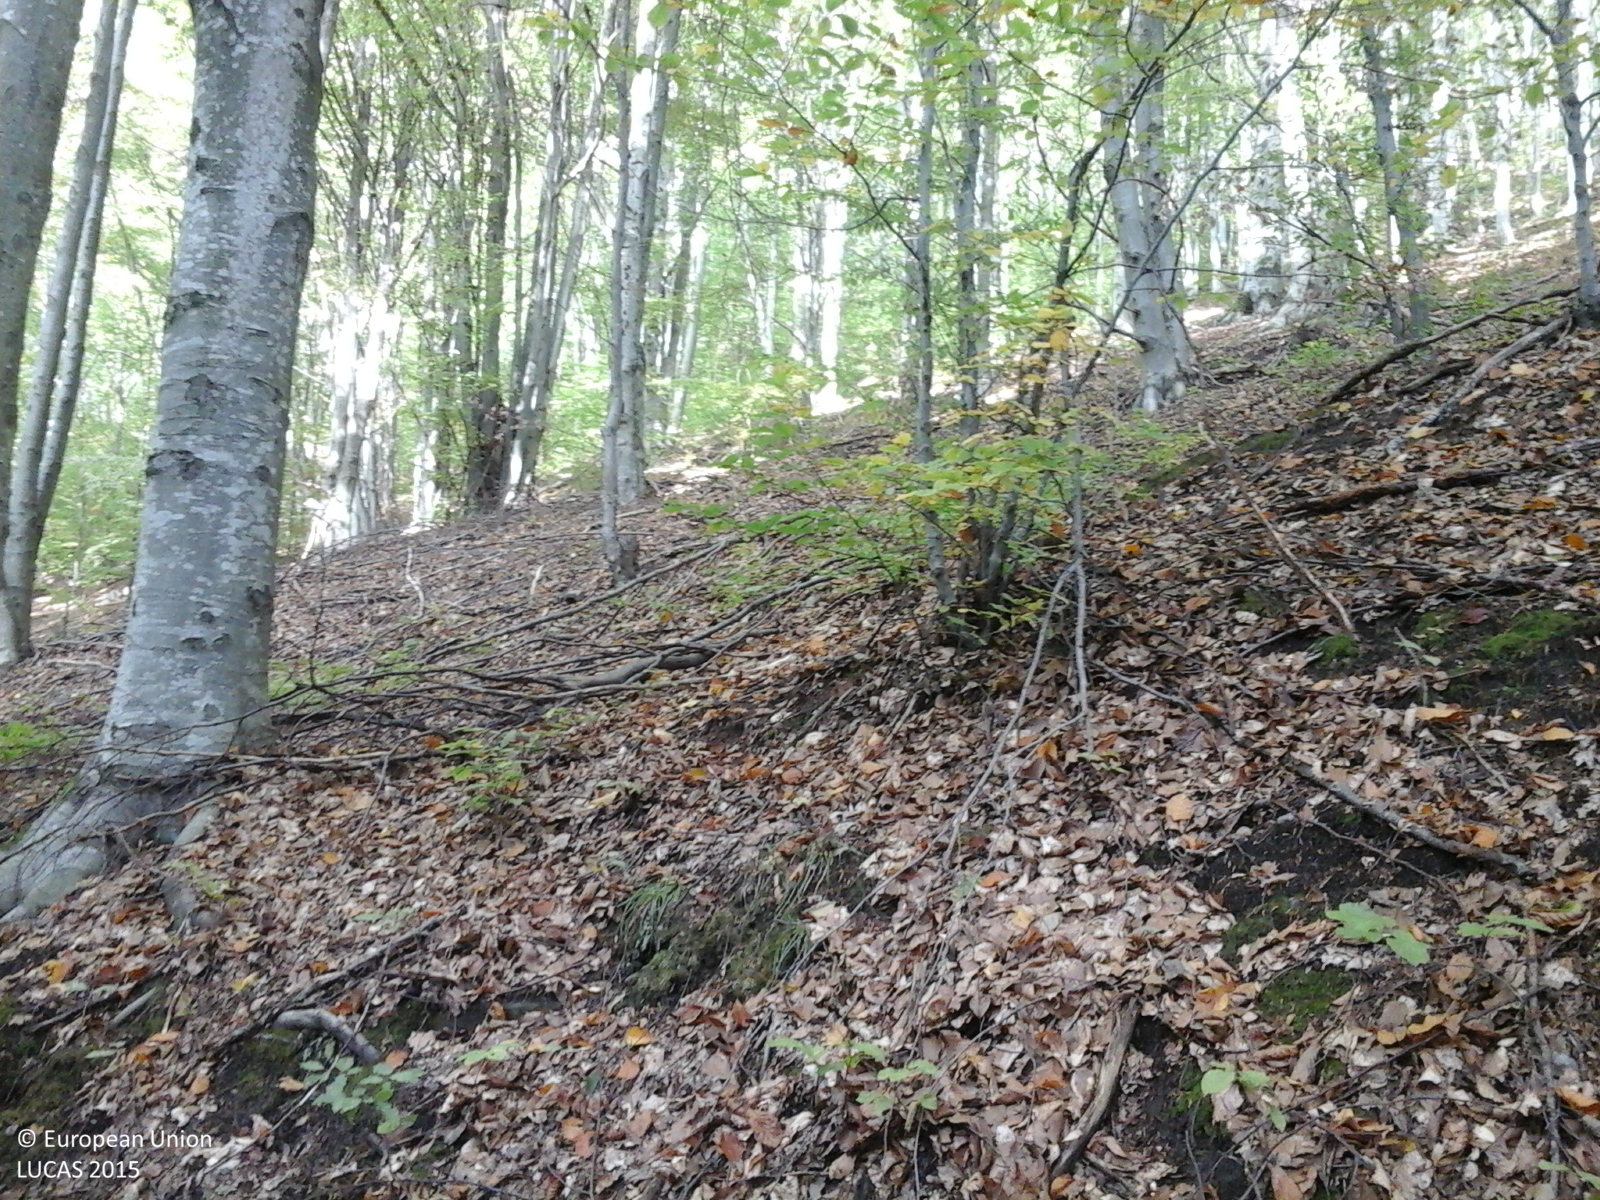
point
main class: Woodland
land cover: Broadleaved woodland
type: beech forest
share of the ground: > 75 %
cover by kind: broadleaved forest trees 100 %
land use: Forestry
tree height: > 5 m
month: October
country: RO
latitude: 46.5442
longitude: 25.1635
